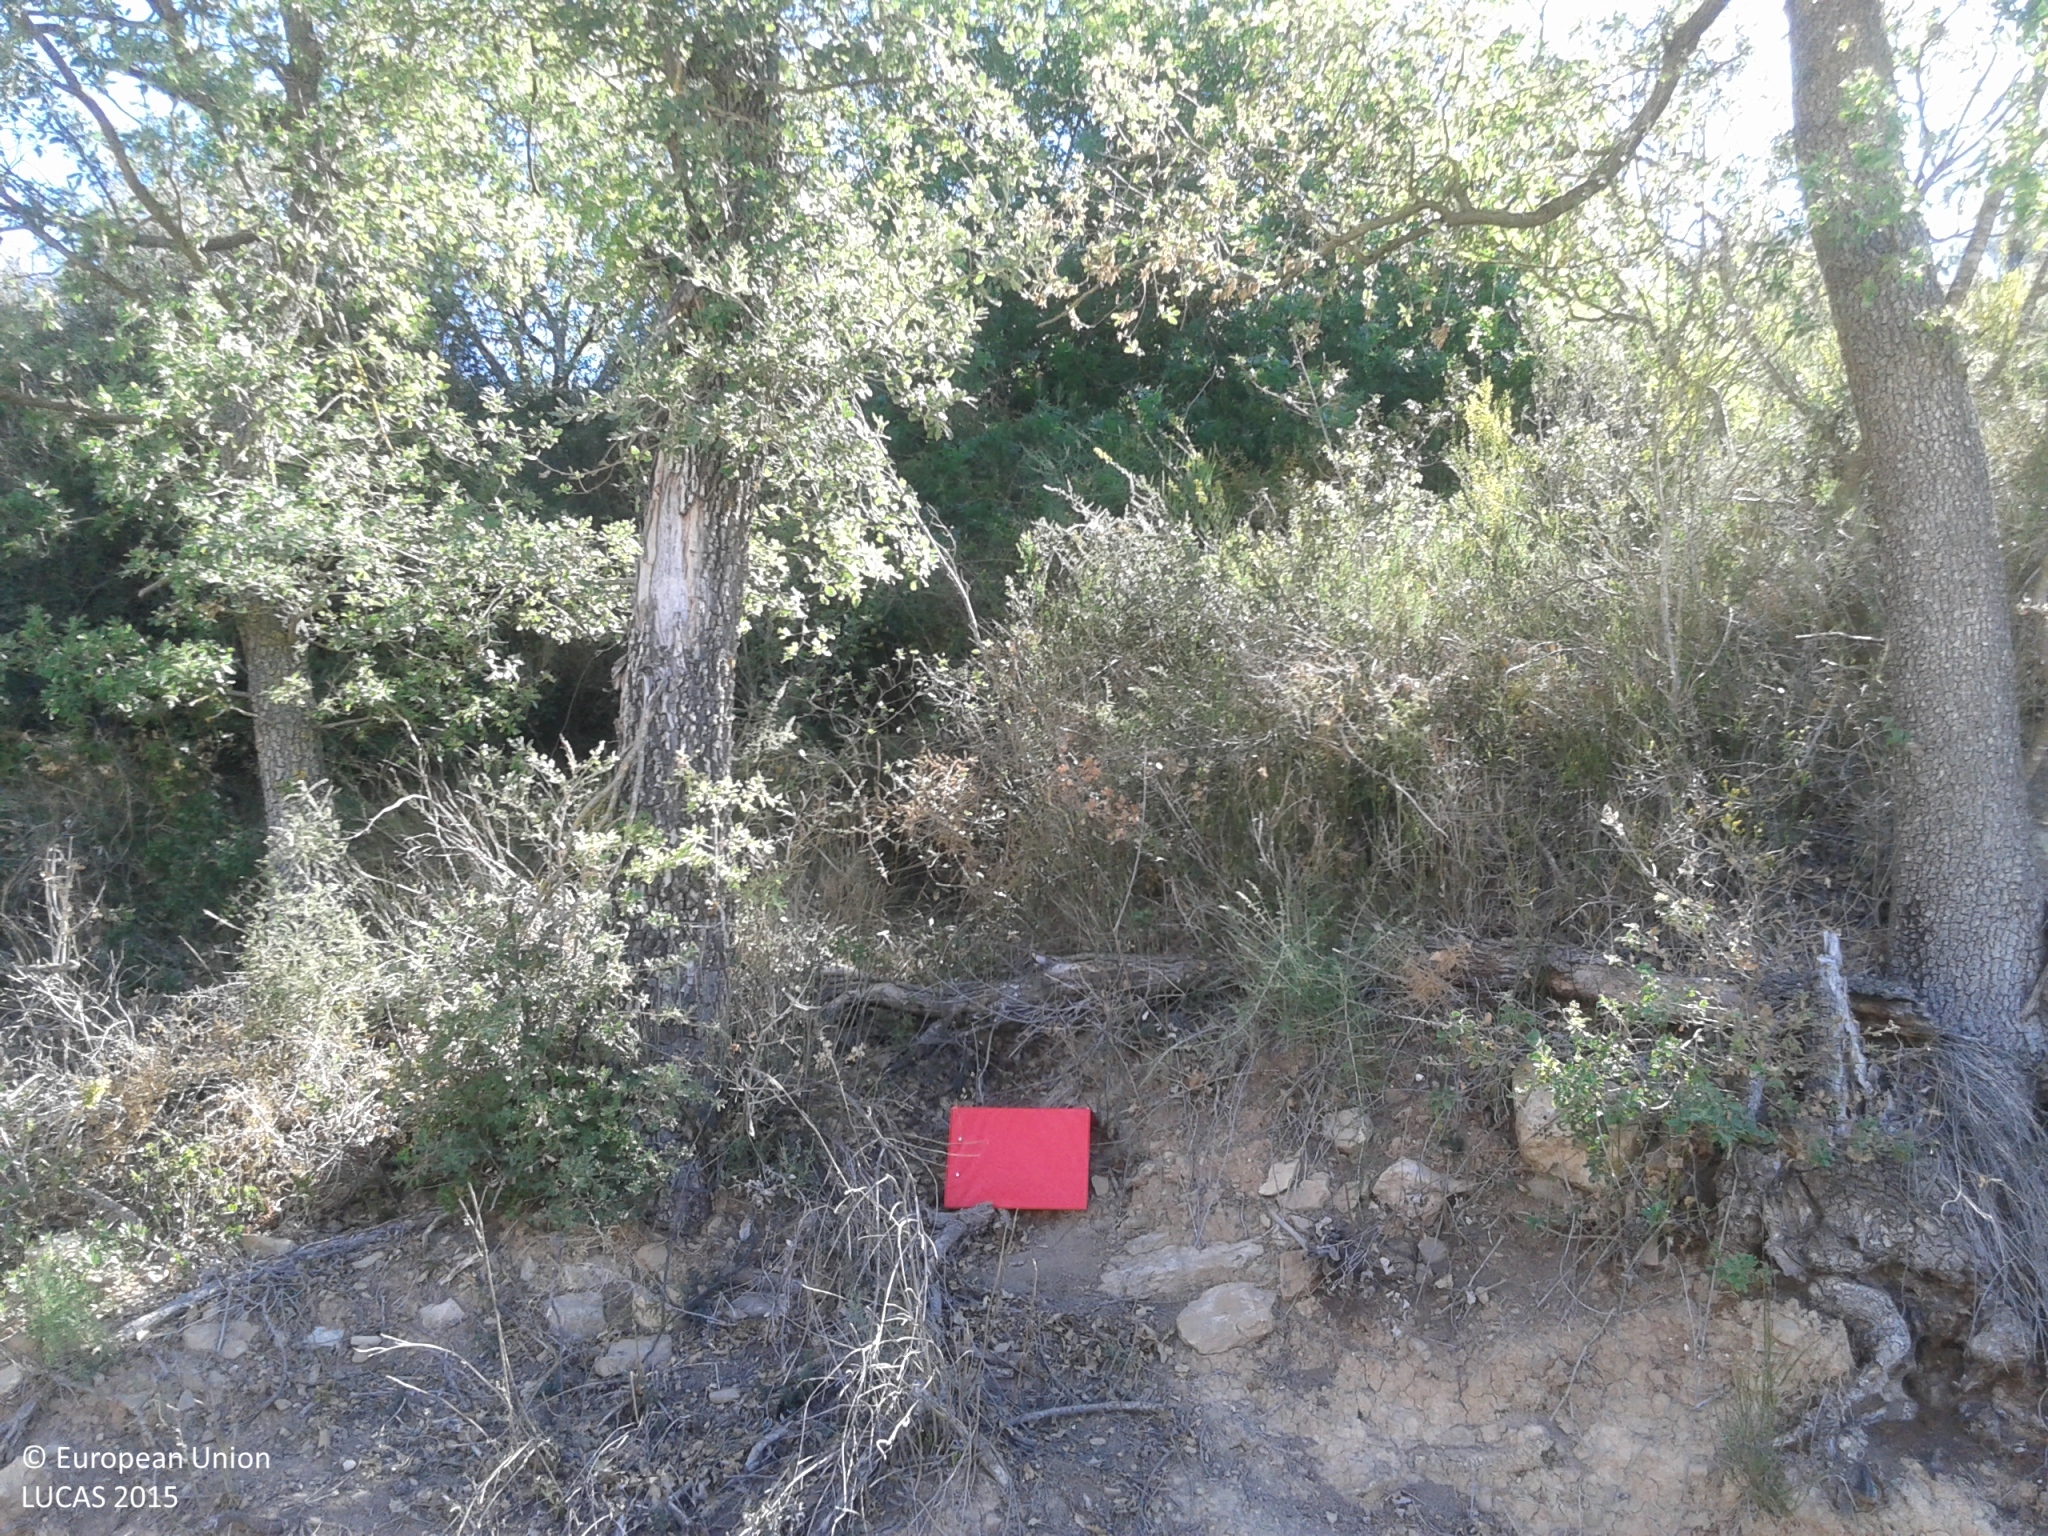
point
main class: Woodland
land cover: Broadleaved woodland
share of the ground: 50 - 75 %
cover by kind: broadleaved forest trees 70 %, shrubs 25 %, herbaceous plants 5 %
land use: Semi-natural and natural areas not in use
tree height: > 5 m
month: May
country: ES
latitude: 41.9324
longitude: 1.0749
